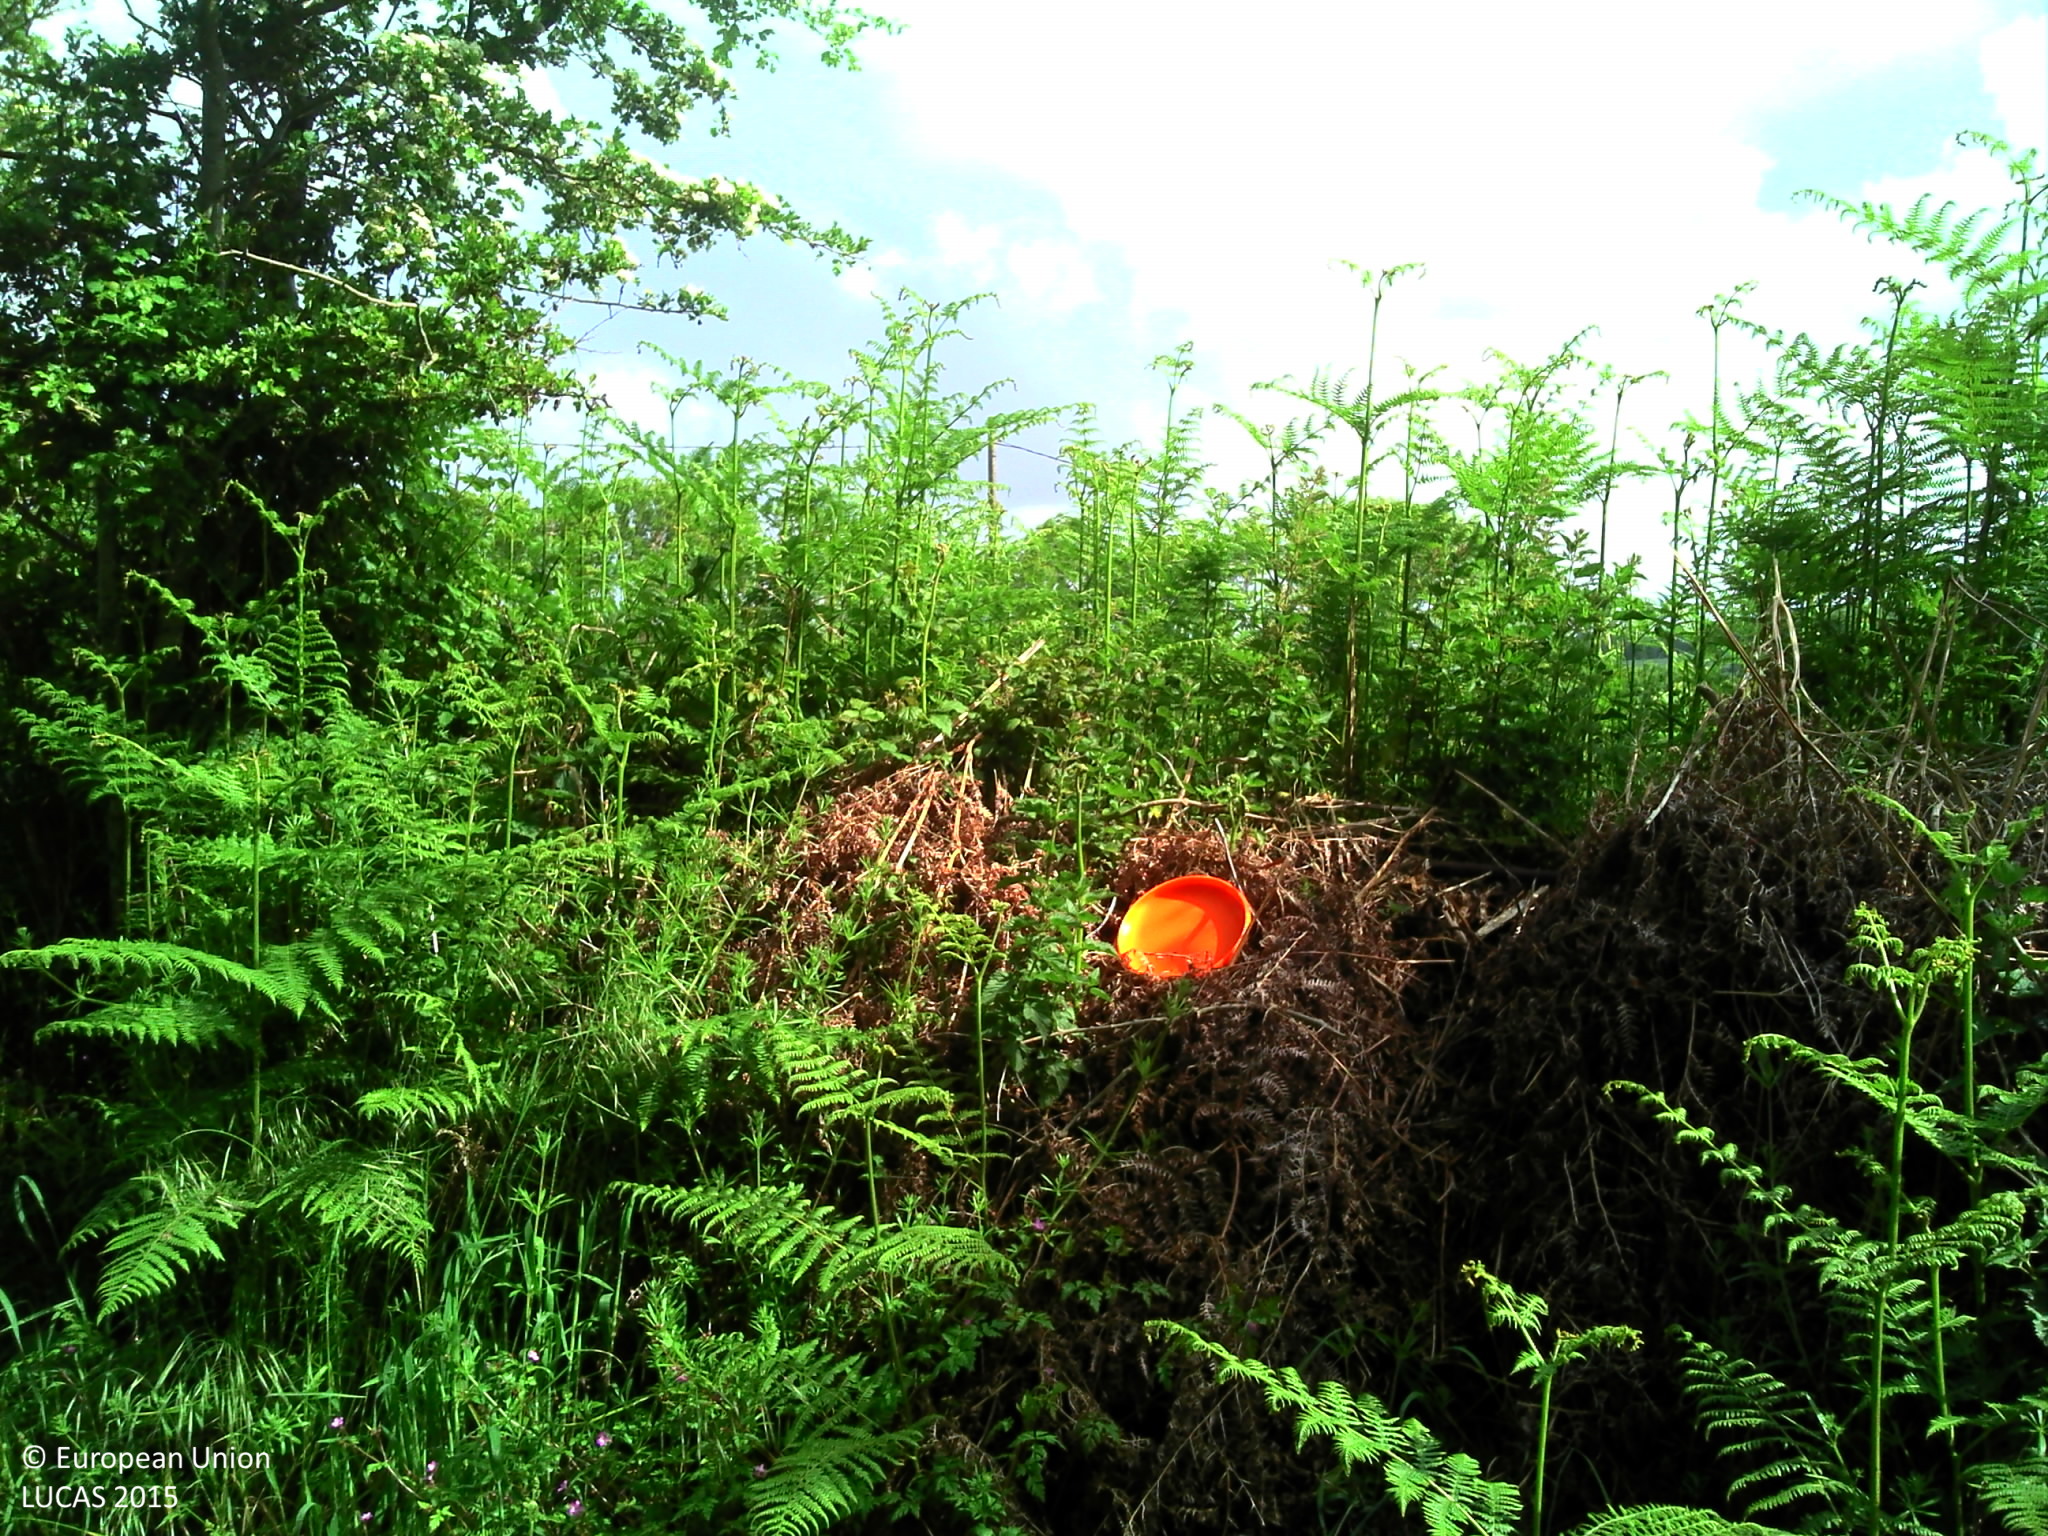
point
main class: Cropland
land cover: Maize
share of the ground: 10 - 25 %
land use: Agriculture (excluding fallow land and kitchen gardens)
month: June
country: FR
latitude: 49.6491
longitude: -1.7286
